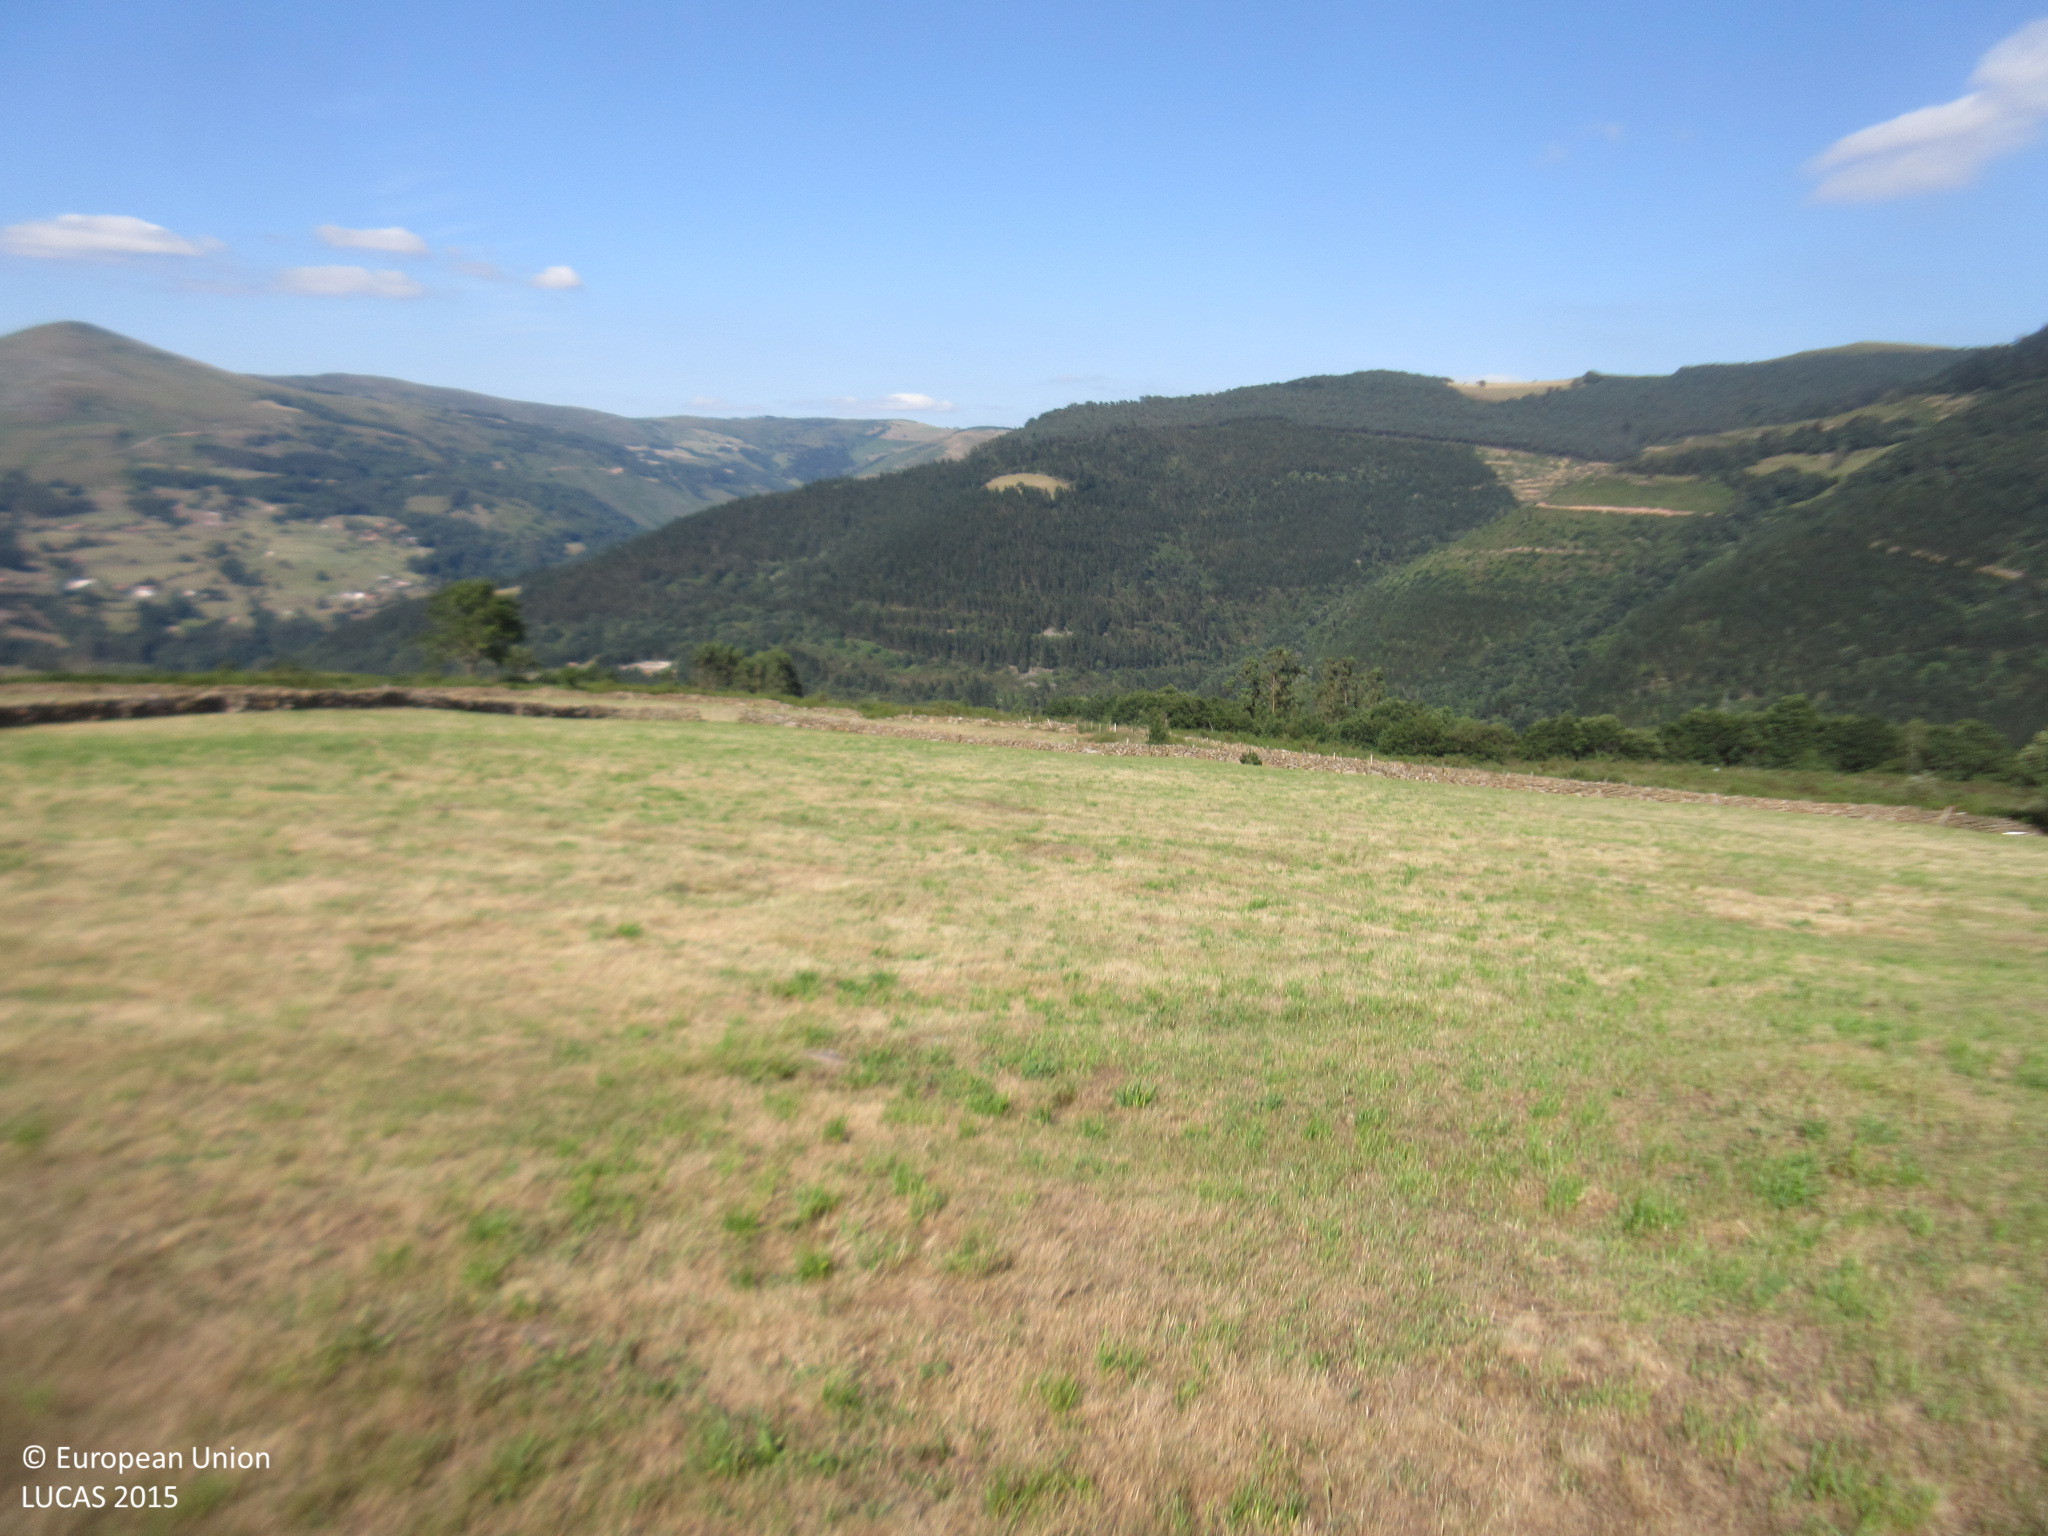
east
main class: Grassland
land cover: Grassland without tree/shrub cover
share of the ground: > 75 %
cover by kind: herbaceous plants 100 %
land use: Agriculture (excluding fallow land and kitchen gardens)
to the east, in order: Dry stone walls; Grassland without tree/shrub cover; Dry stone walls; Grassland without tree/shrub cover; Dry stone walls; Shrubland without tree cover; Tracks; Shrubland without tree cover
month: July
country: ES
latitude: 43.1529
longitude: -3.9068
